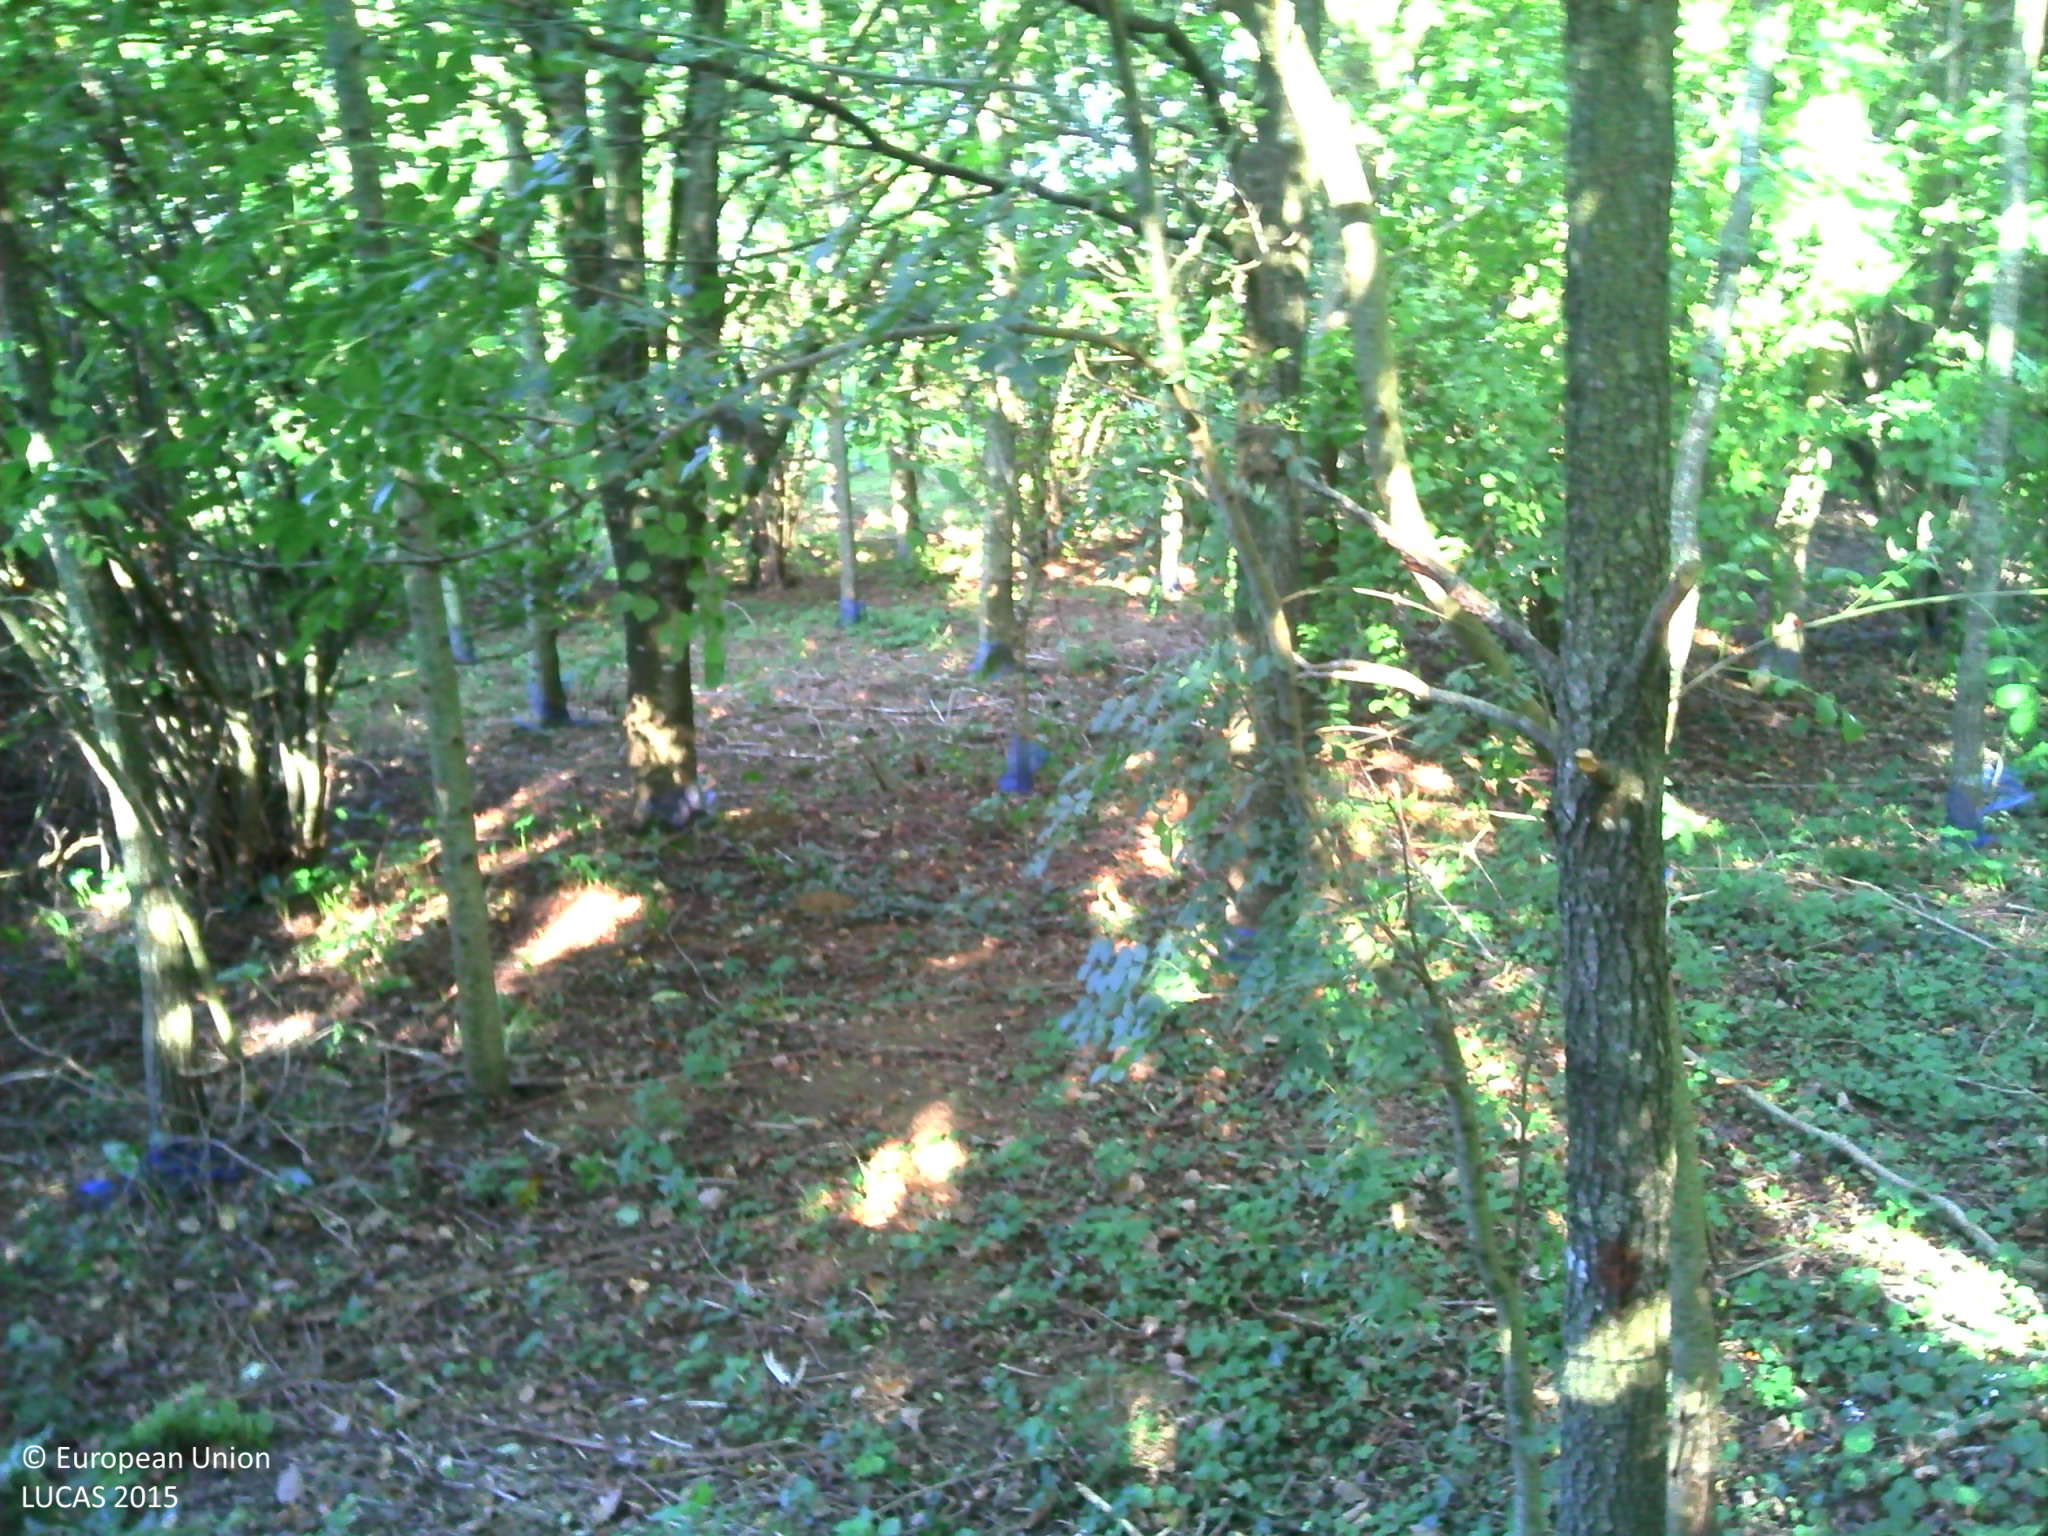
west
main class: Woodland
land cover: Broadleaved woodland
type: mesophytic deciduous forest
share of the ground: > 75 %
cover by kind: broadleaved forest trees 80 %, herbaceous plants 20 %
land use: Forestry
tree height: > 5 m
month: September
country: FR
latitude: 46.5550
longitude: -1.0808
